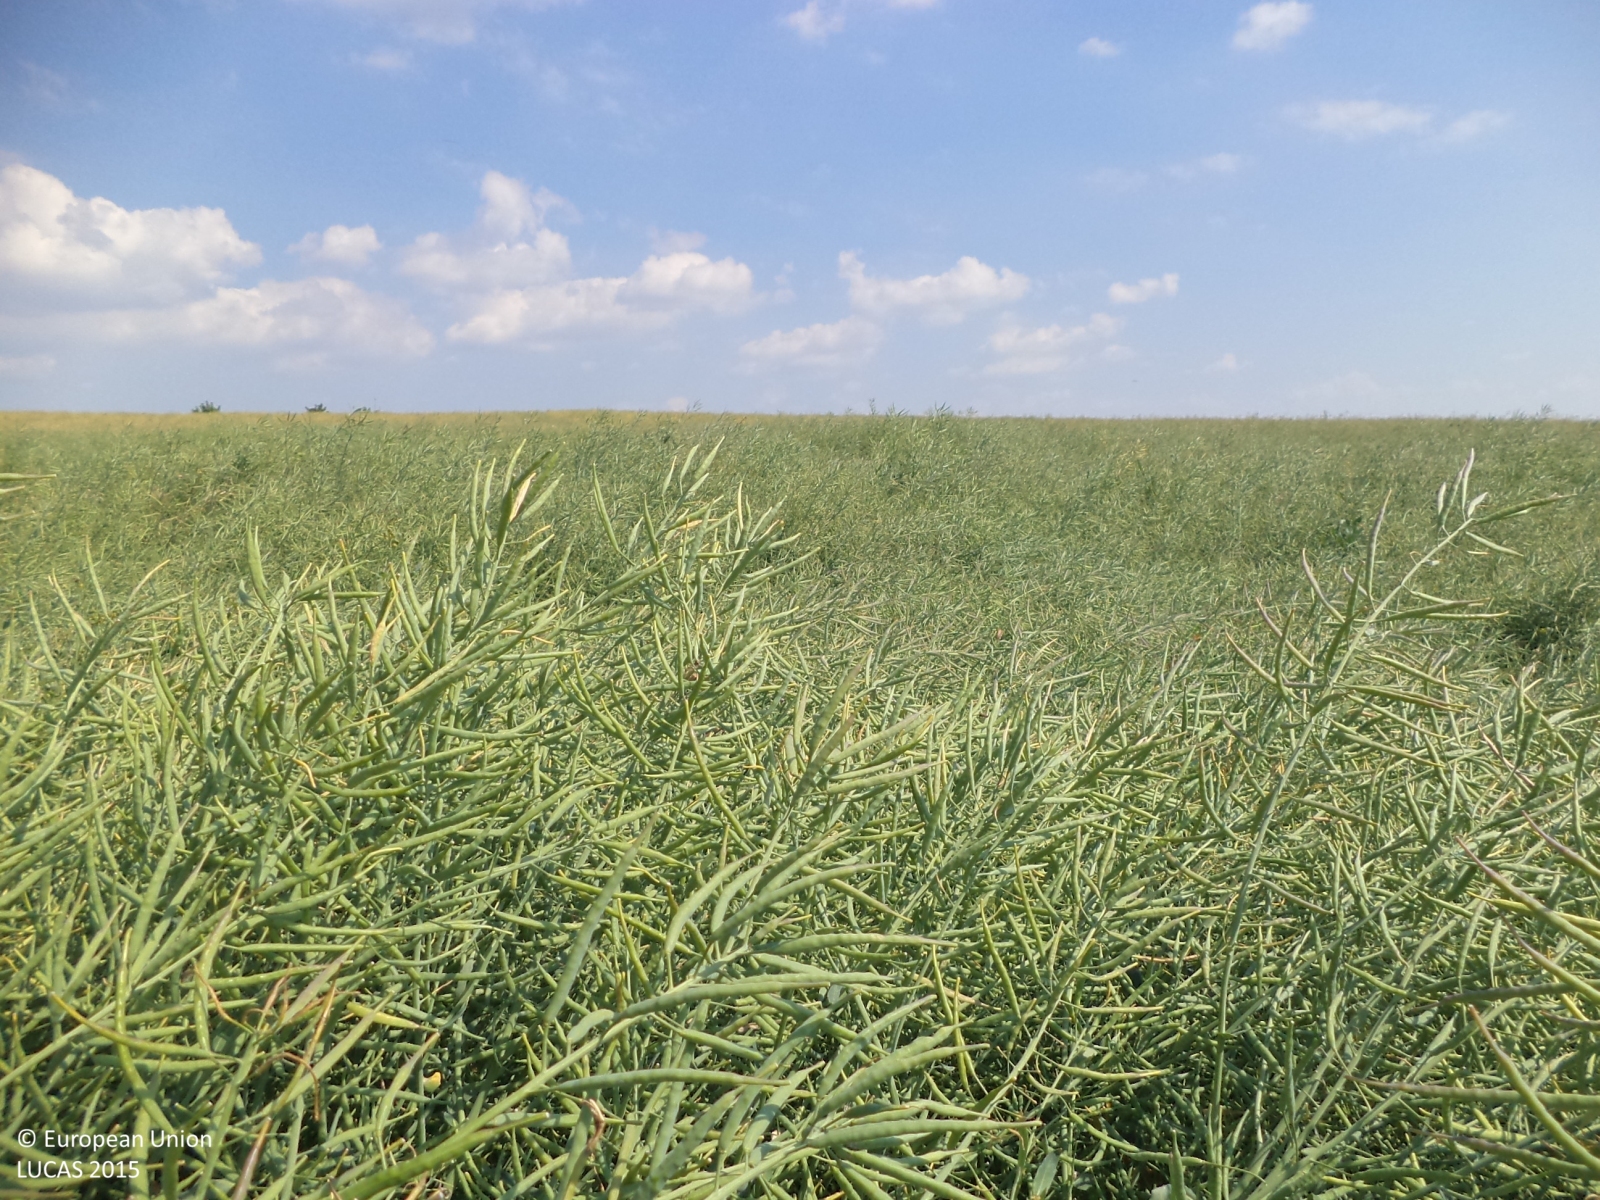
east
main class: Cropland
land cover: Rape and turnip rape
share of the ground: > 75 %
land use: Agriculture (excluding fallow land and kitchen gardens)
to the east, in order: Rape and turnip rape
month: July
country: CZ
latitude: 49.3622
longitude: 14.3660
